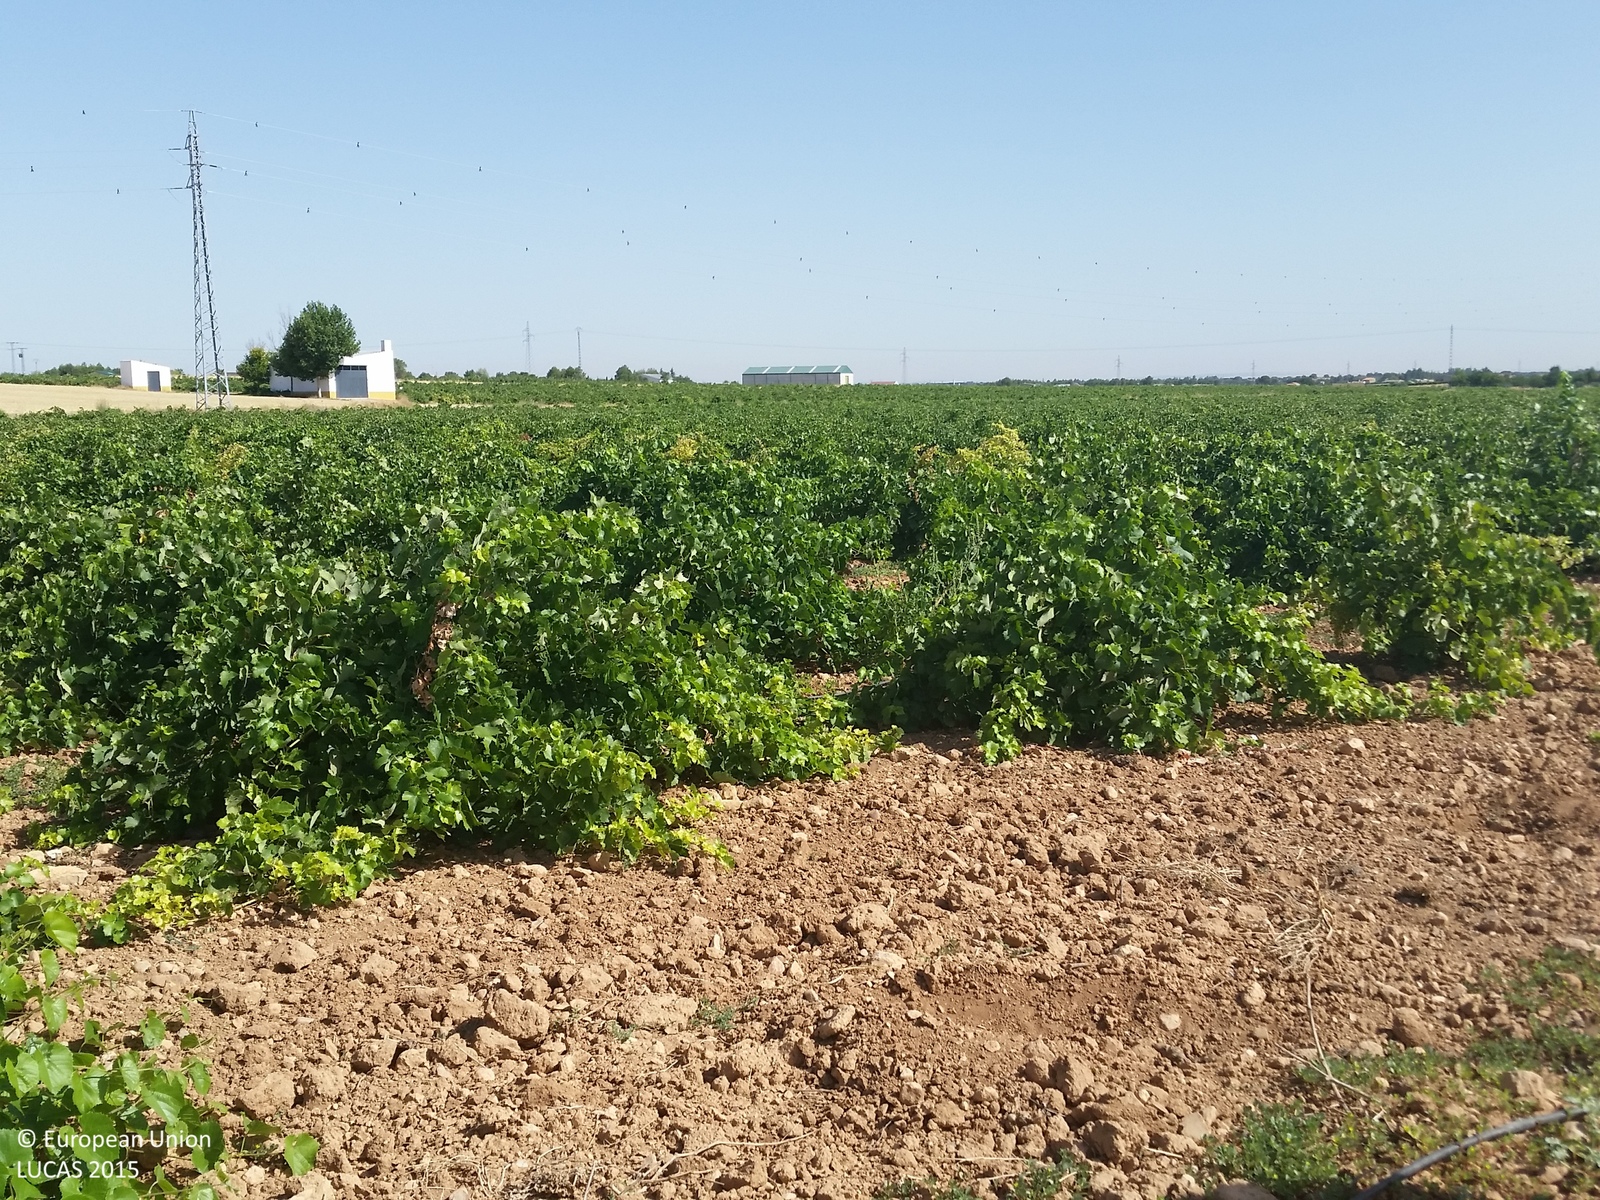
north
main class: Cropland
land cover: Vineyards
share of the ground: 50 - 75 %
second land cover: Other bare soil
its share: > 75 %
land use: Agriculture (excluding fallow land and kitchen gardens)
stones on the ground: 10 - 25 %
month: July
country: ES
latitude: 39.2882
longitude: -2.5896
